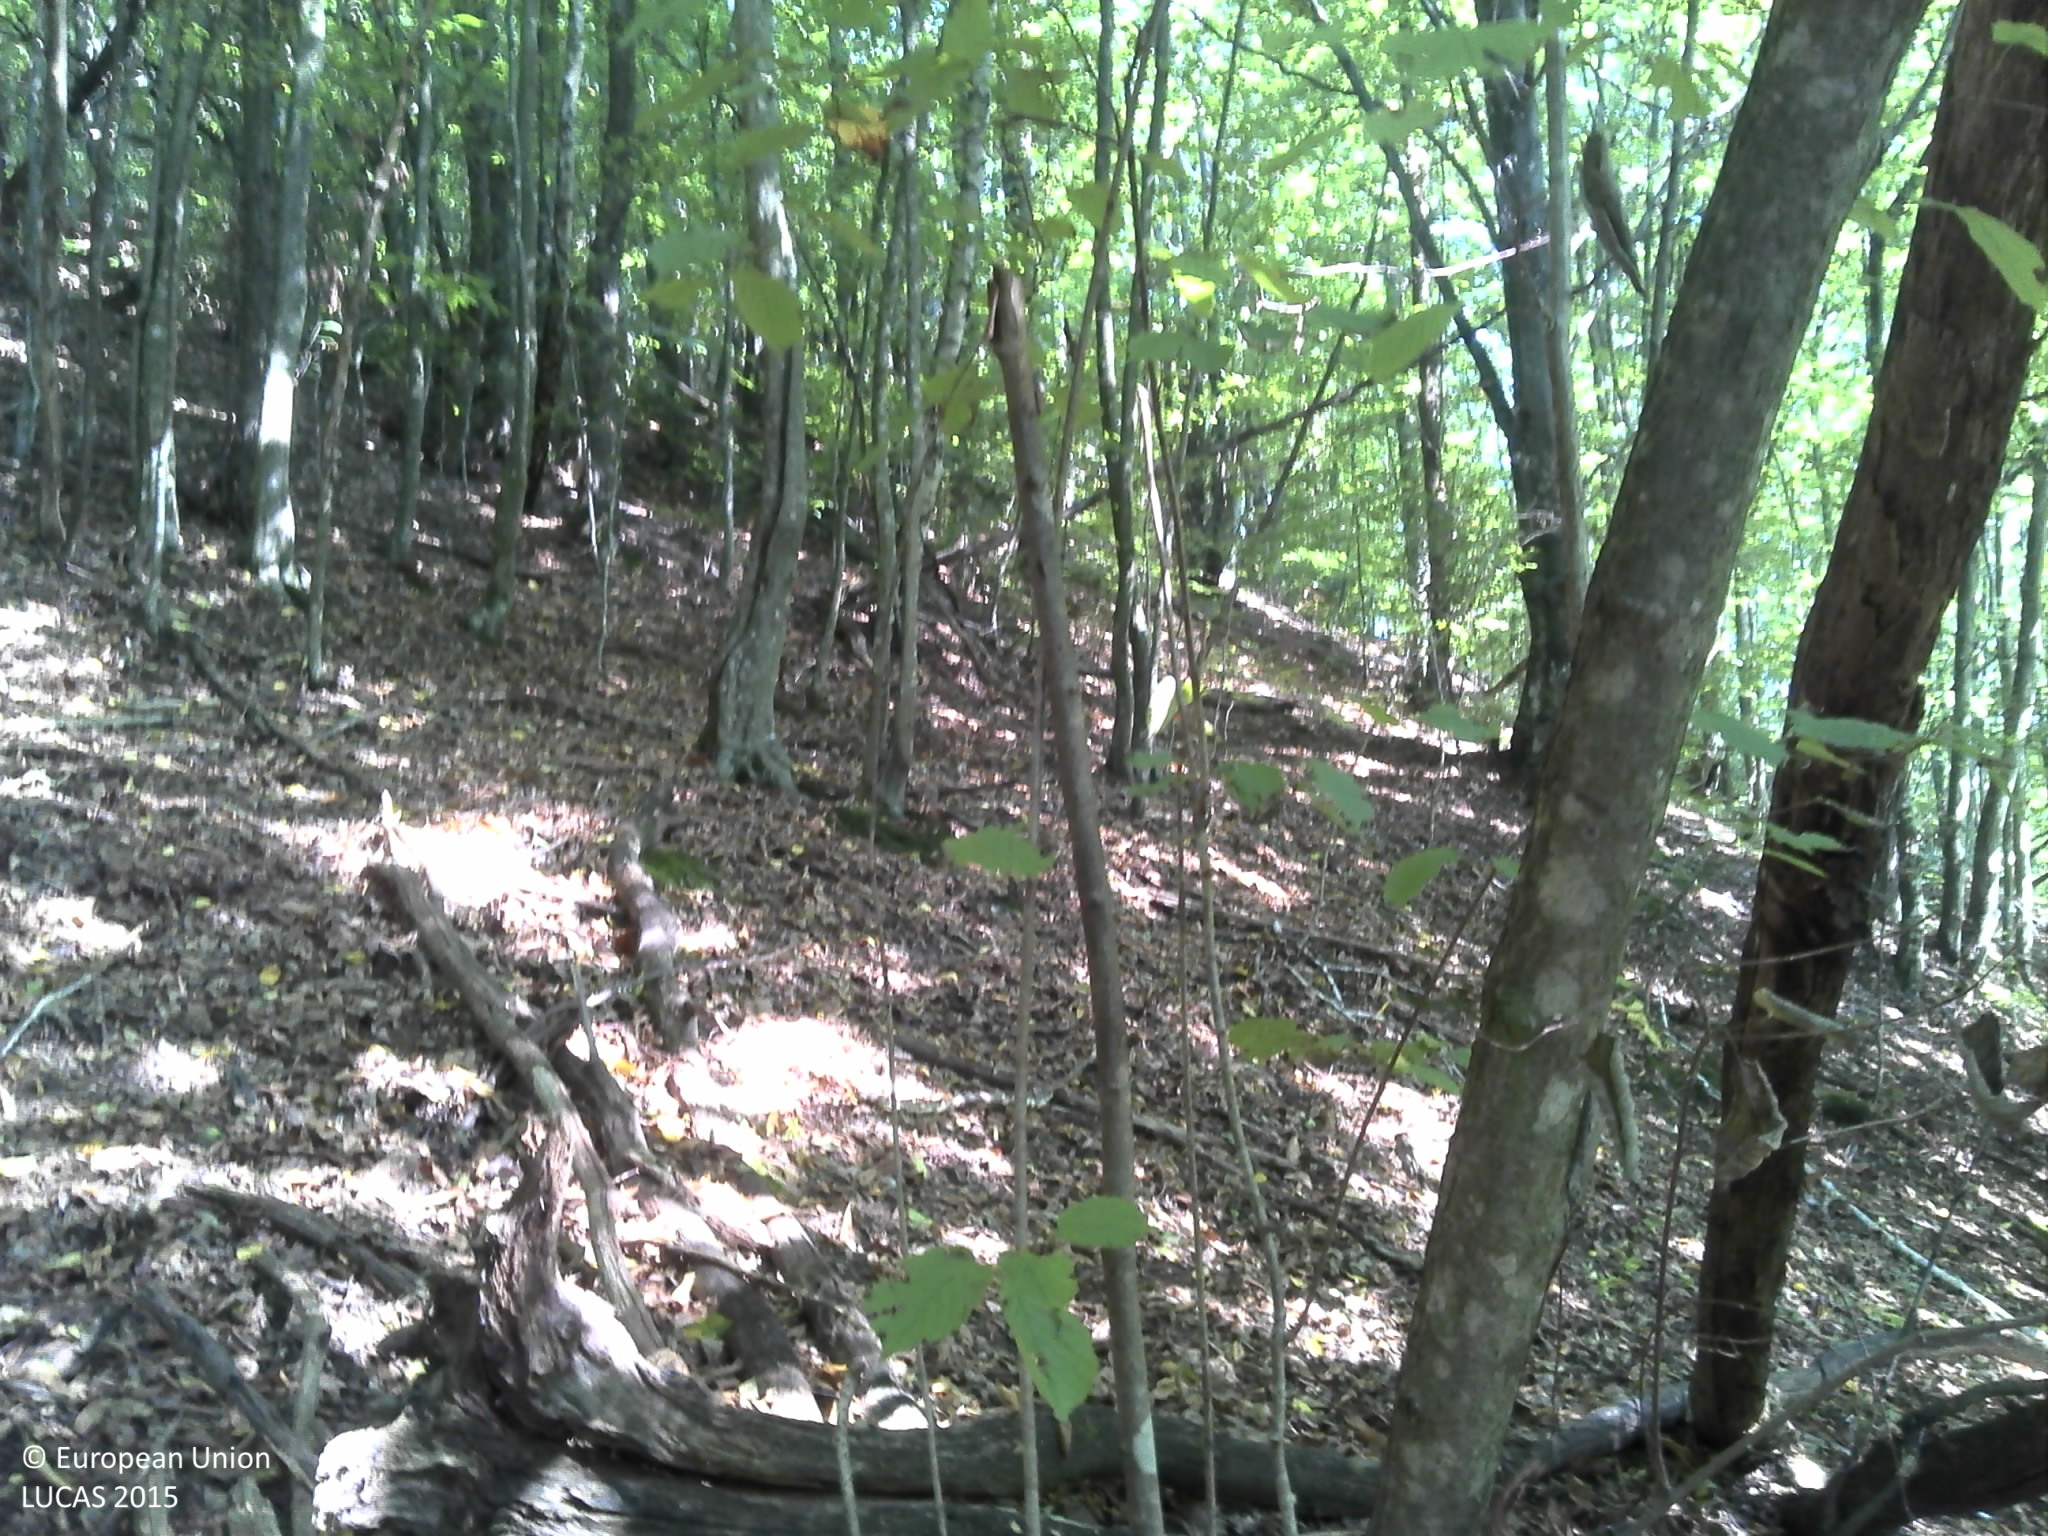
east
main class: Woodland
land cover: Broadleaved woodland
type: beech forest
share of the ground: > 75 %
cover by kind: broadleaved forest trees 100 %
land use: Forestry
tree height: > 5 m
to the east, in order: Broadleaved woodland; Rivers and streams; Broadleaved woodland
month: August
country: HR
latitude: 45.2407
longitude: 16.3539
